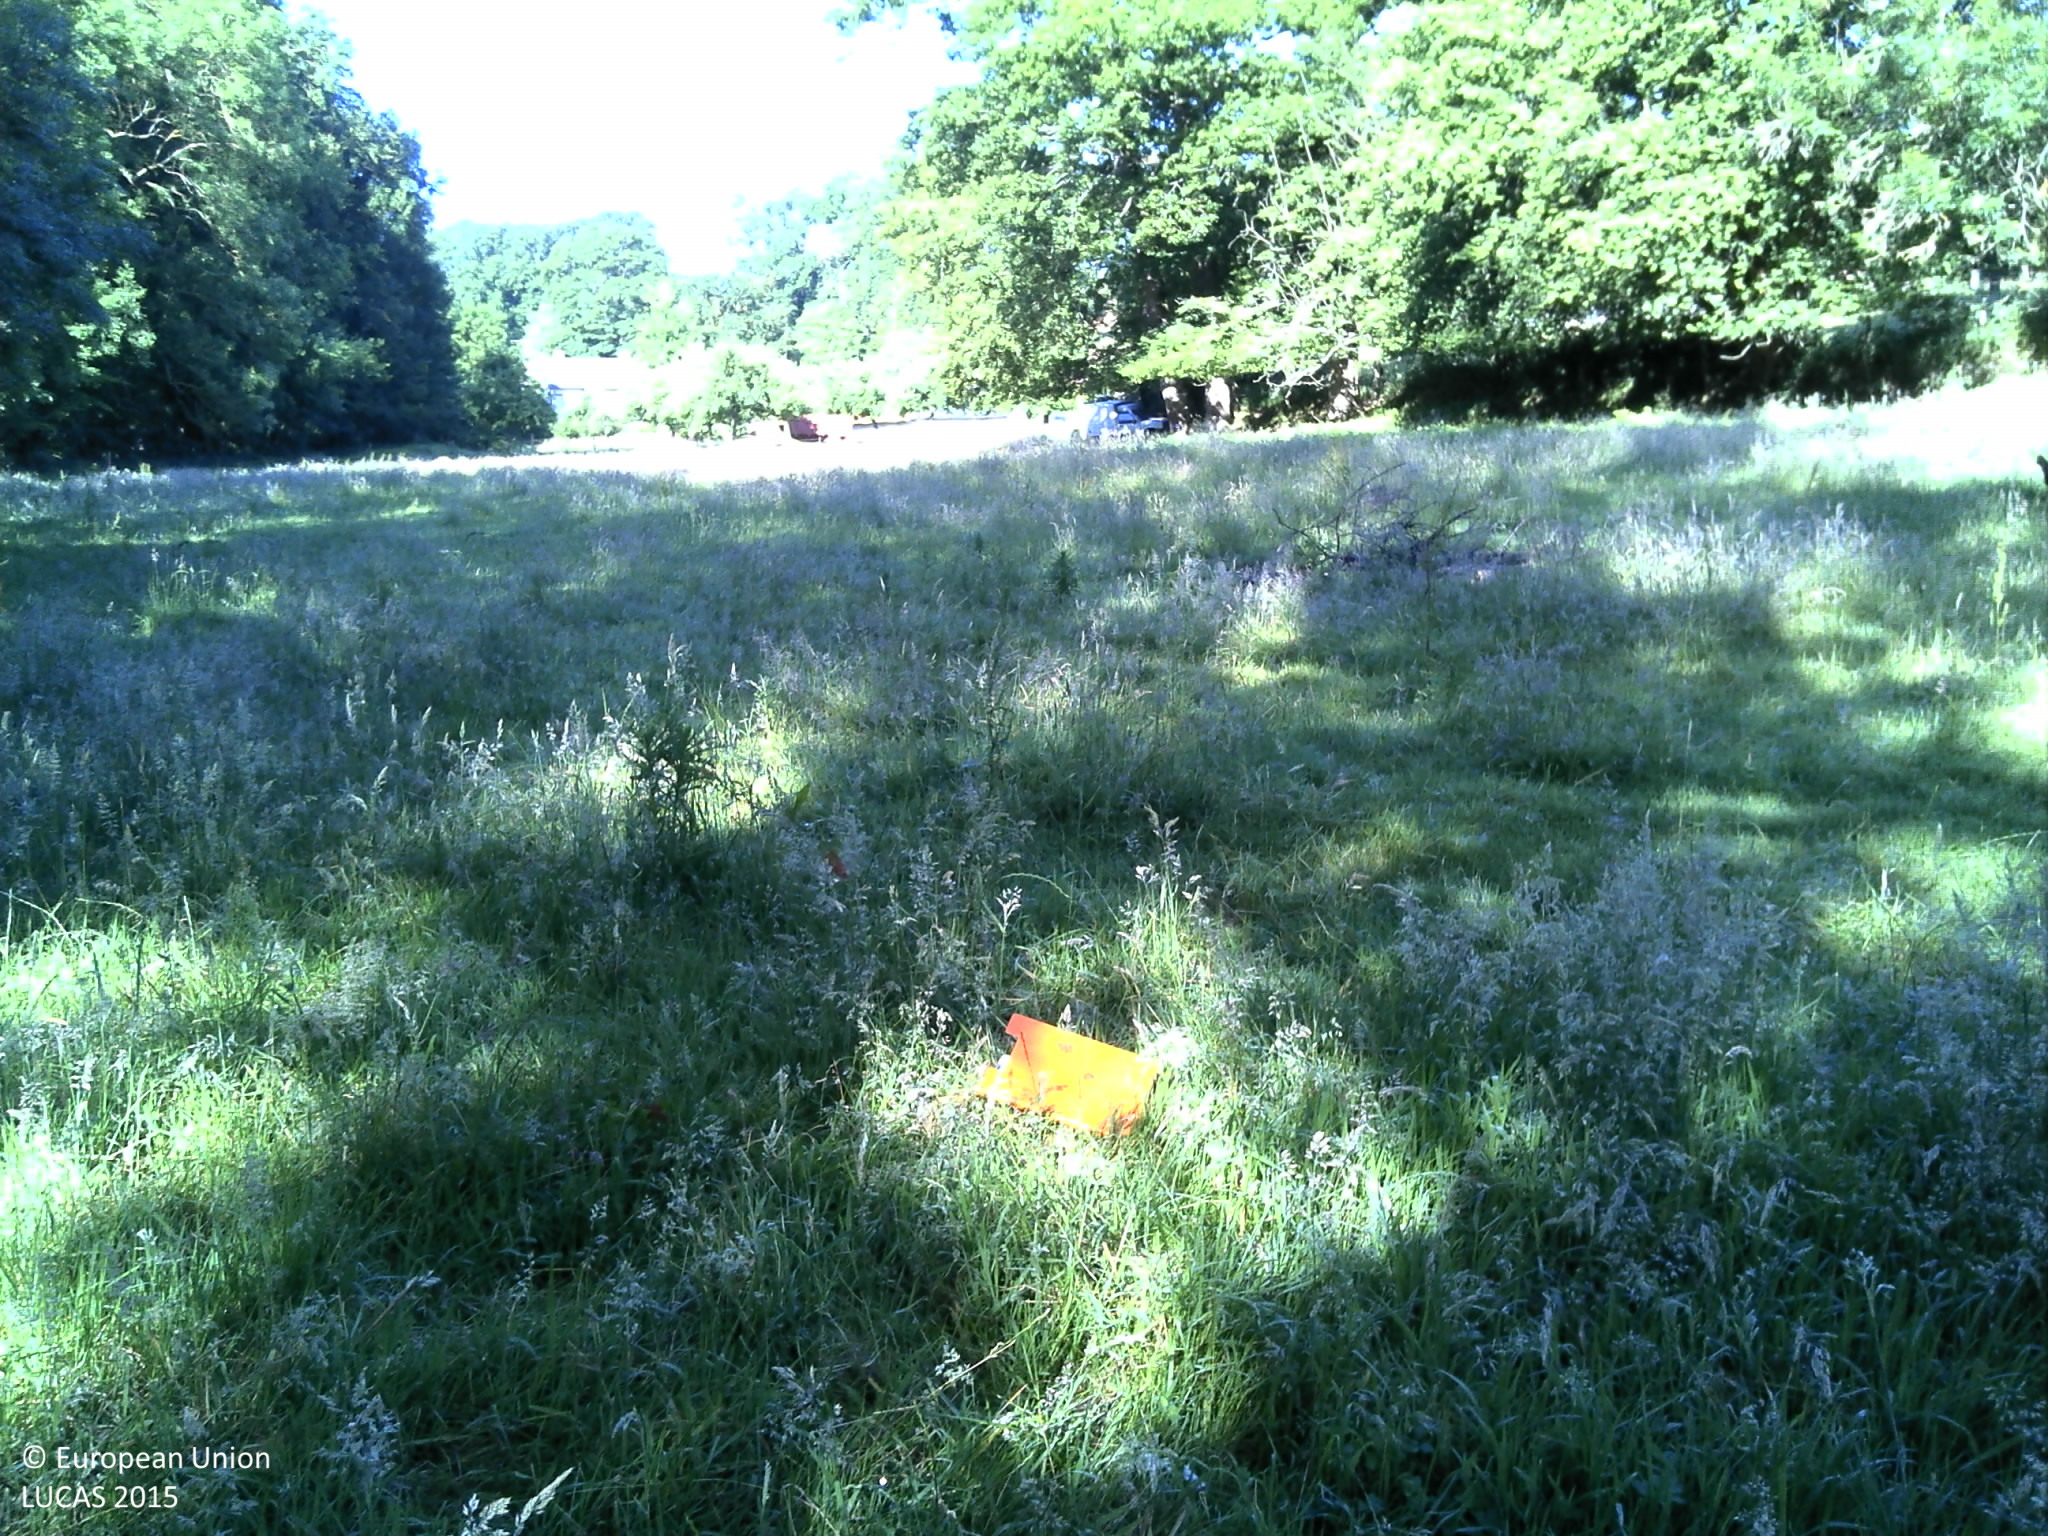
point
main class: Grassland
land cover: Grassland without tree/shrub cover
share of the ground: > 75 %
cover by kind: herbaceous plants 100 %
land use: Agriculture (excluding fallow land and kitchen gardens)
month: June
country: FR
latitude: 49.8085
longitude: 0.9866
